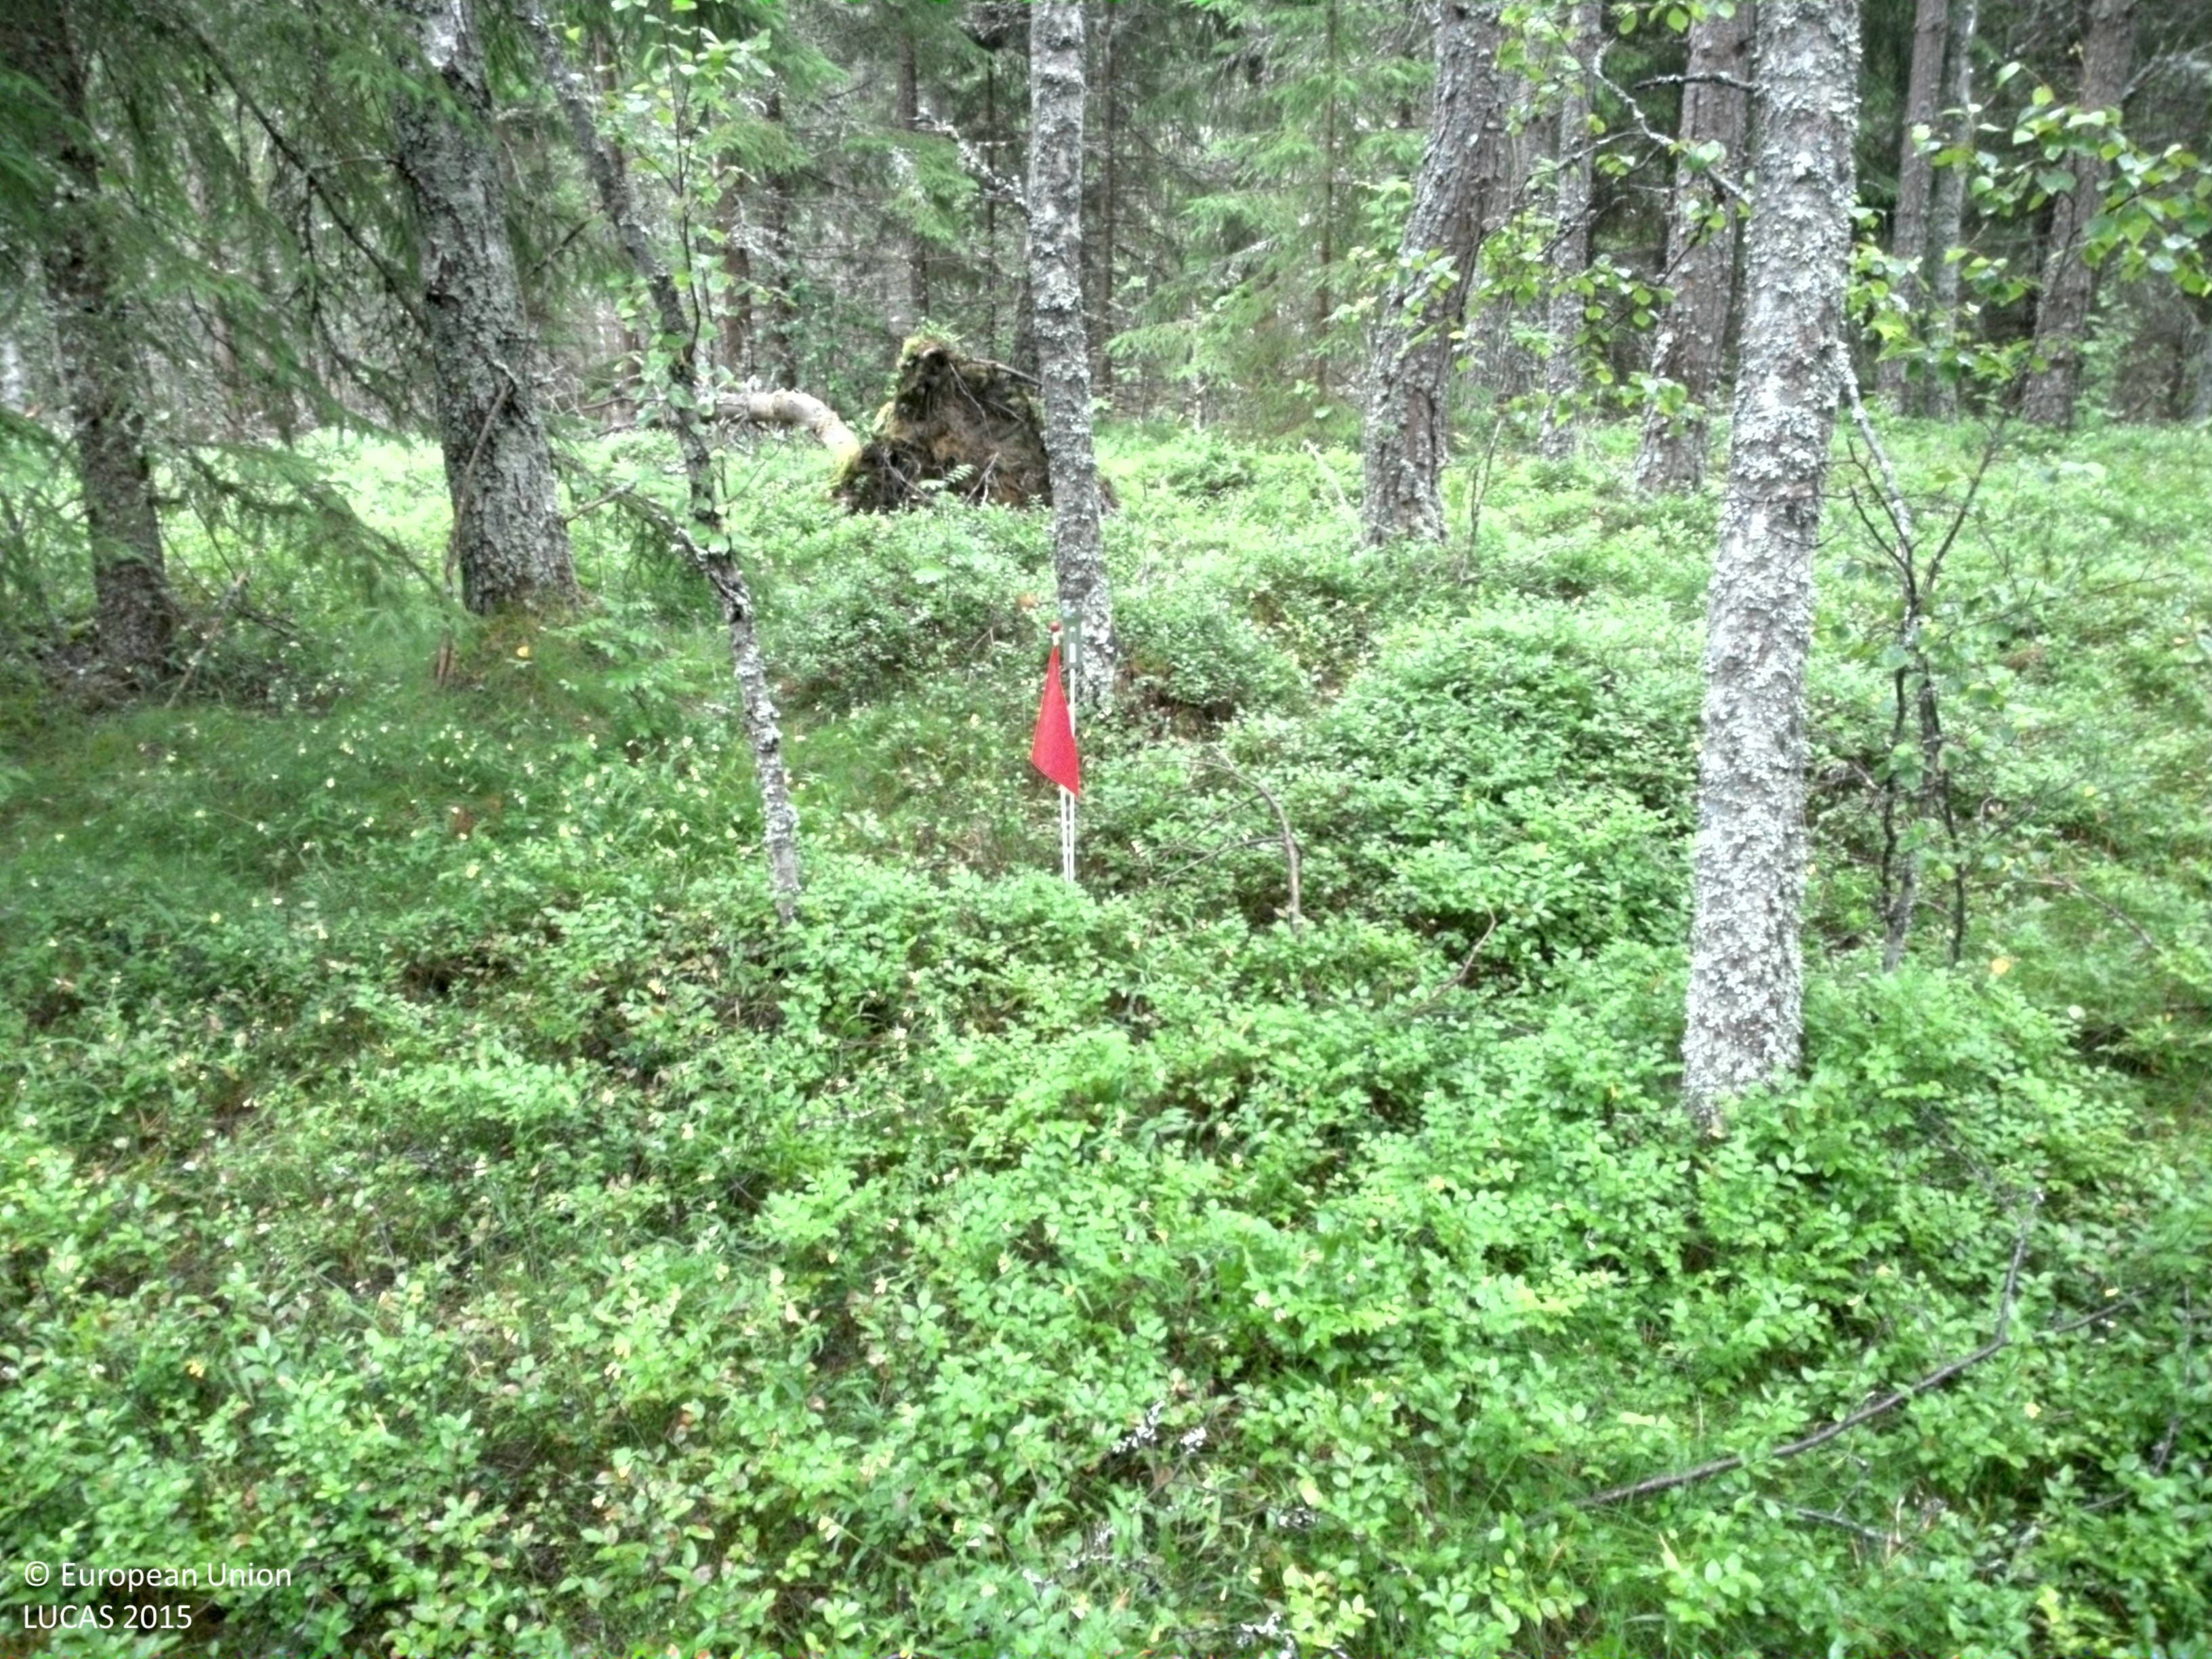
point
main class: Woodland
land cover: Pine dominated mixed woodland
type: boreal forest
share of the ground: 50 - 75 %
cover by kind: coniferous forest trees 55 %, broadleaved forest trees 20 %, shrubs 20 %, lichens and mosses 5 %
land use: Forestry
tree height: > 5 m
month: July
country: SE
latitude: 57.7034
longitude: 14.7443
